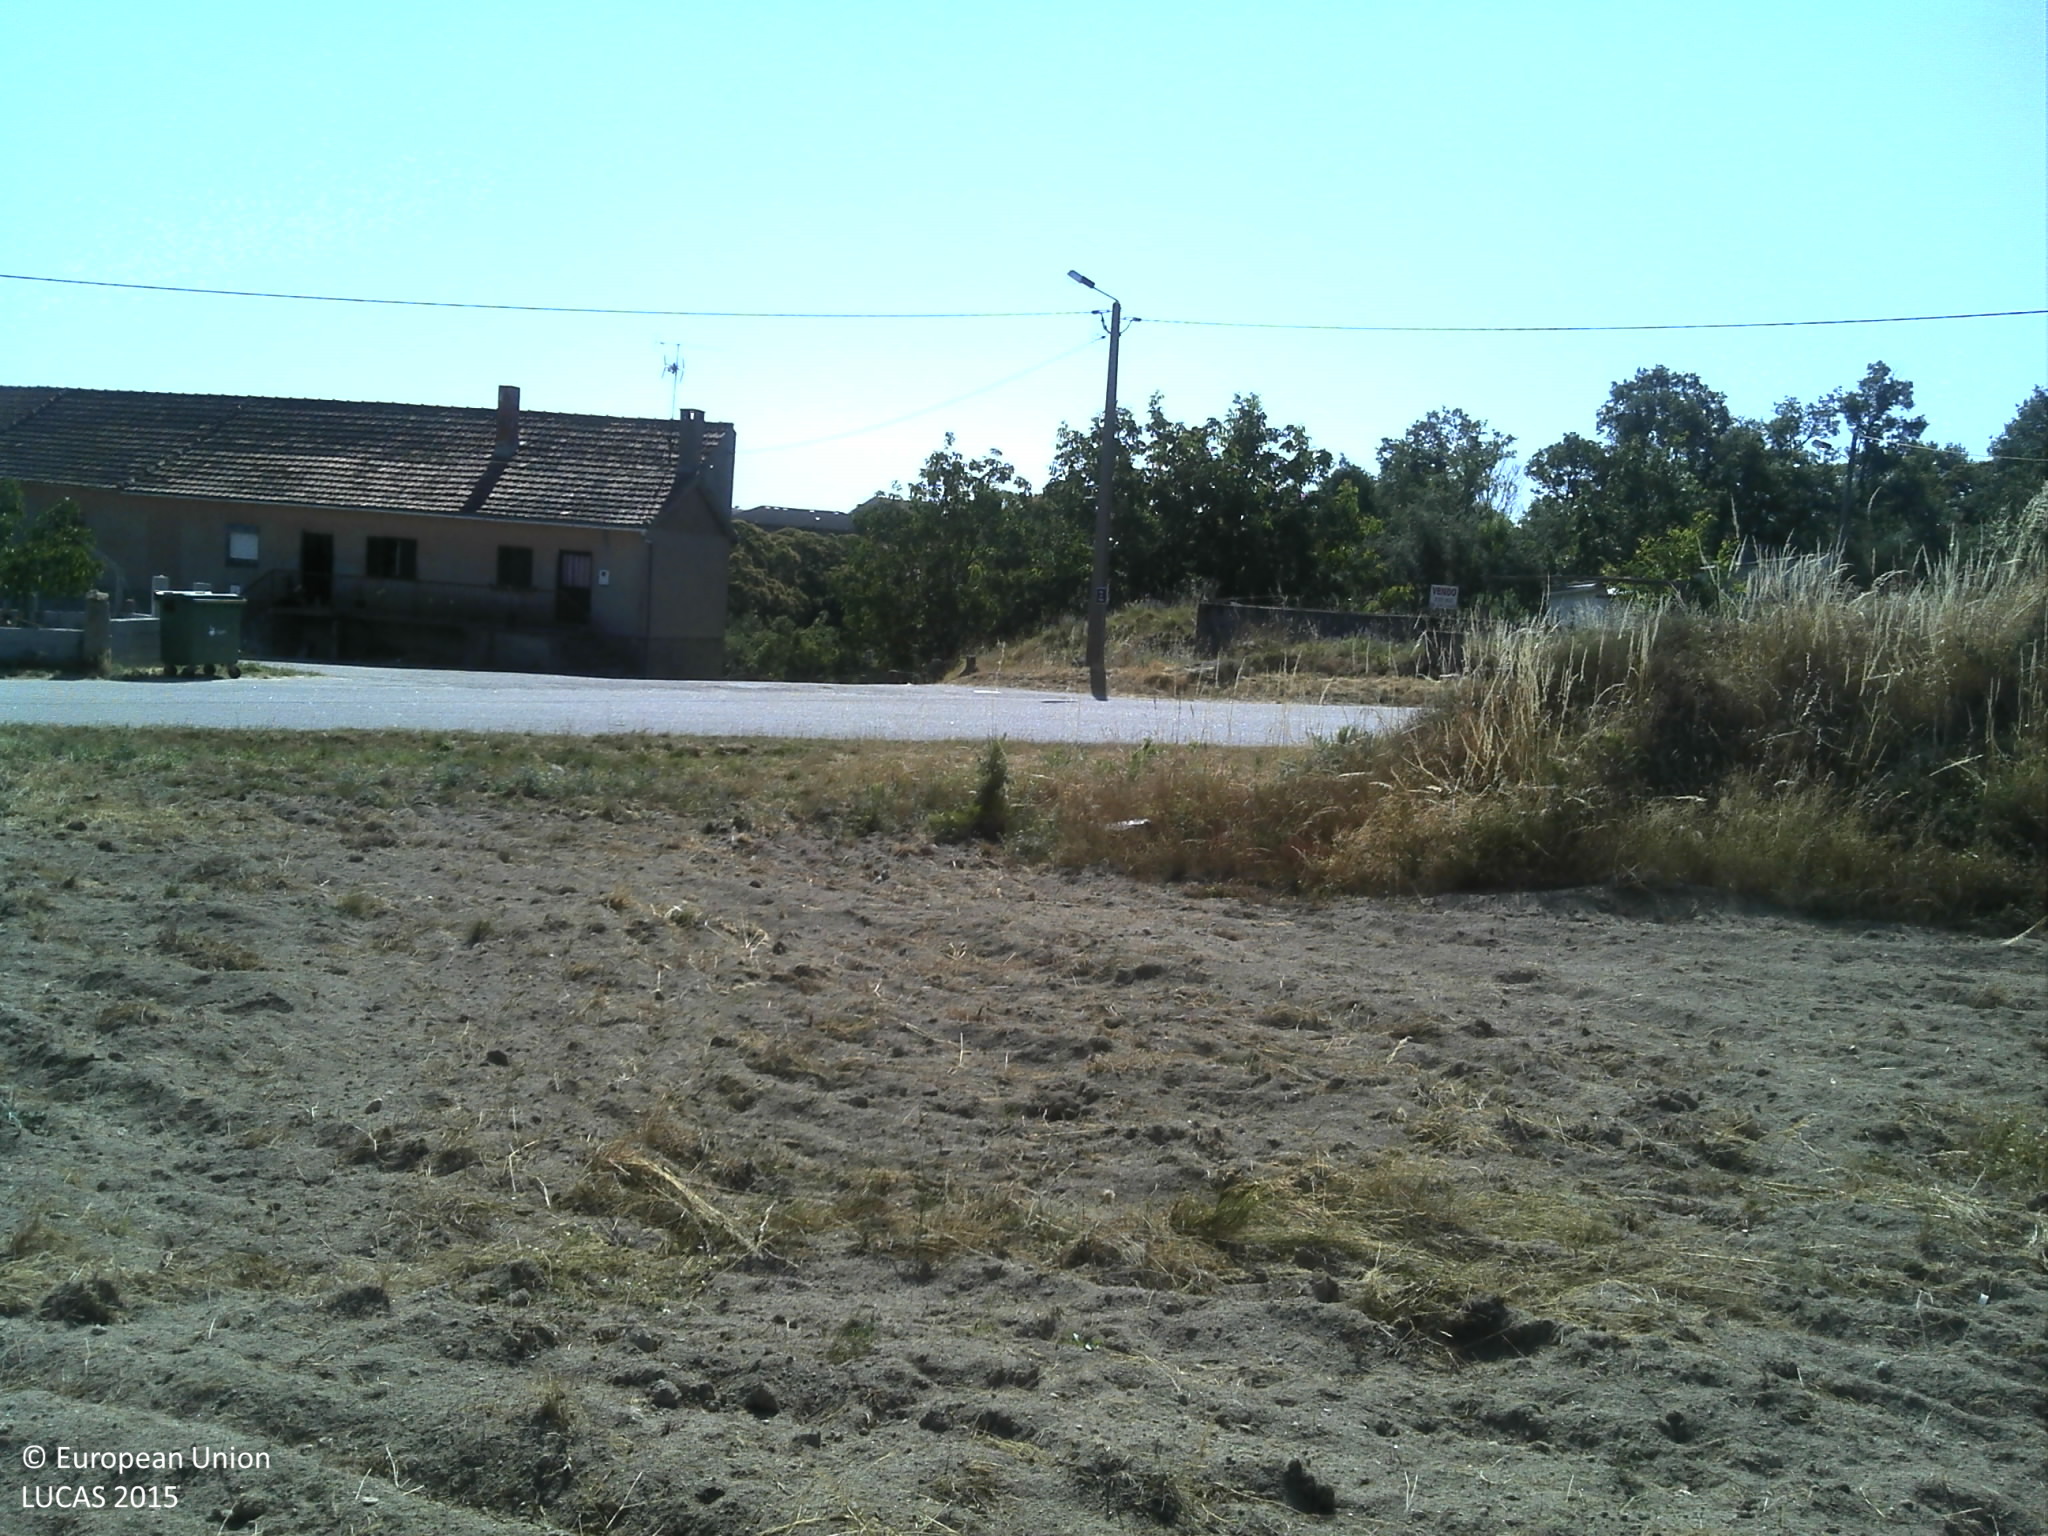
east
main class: Cropland
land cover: Other fruit trees and berries
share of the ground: 10 - 25 %
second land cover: Other bare soil
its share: > 75 %
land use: Agriculture (excluding fallow land and kitchen gardens)
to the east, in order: Other fruit trees and berries; Other bare soil; Grass margins; Artificial constructions in urban areas; Other fresh vegetables; Single bushes/trees; Apple fruit; Dry stone walls; Apple fruit; Nuts trees; Dry stone walls; Grassland without tree/shrub cover; Dry stone walls; Abandoned hedges; Grassland without tree/shrub cover; Electric lines; Grassland without tree/shrub cover; Dry stone walls; Grassland without tree/shrub cover; Artificial constructions in urban areas
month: July
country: PT
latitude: 41.8481
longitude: -7.6364
